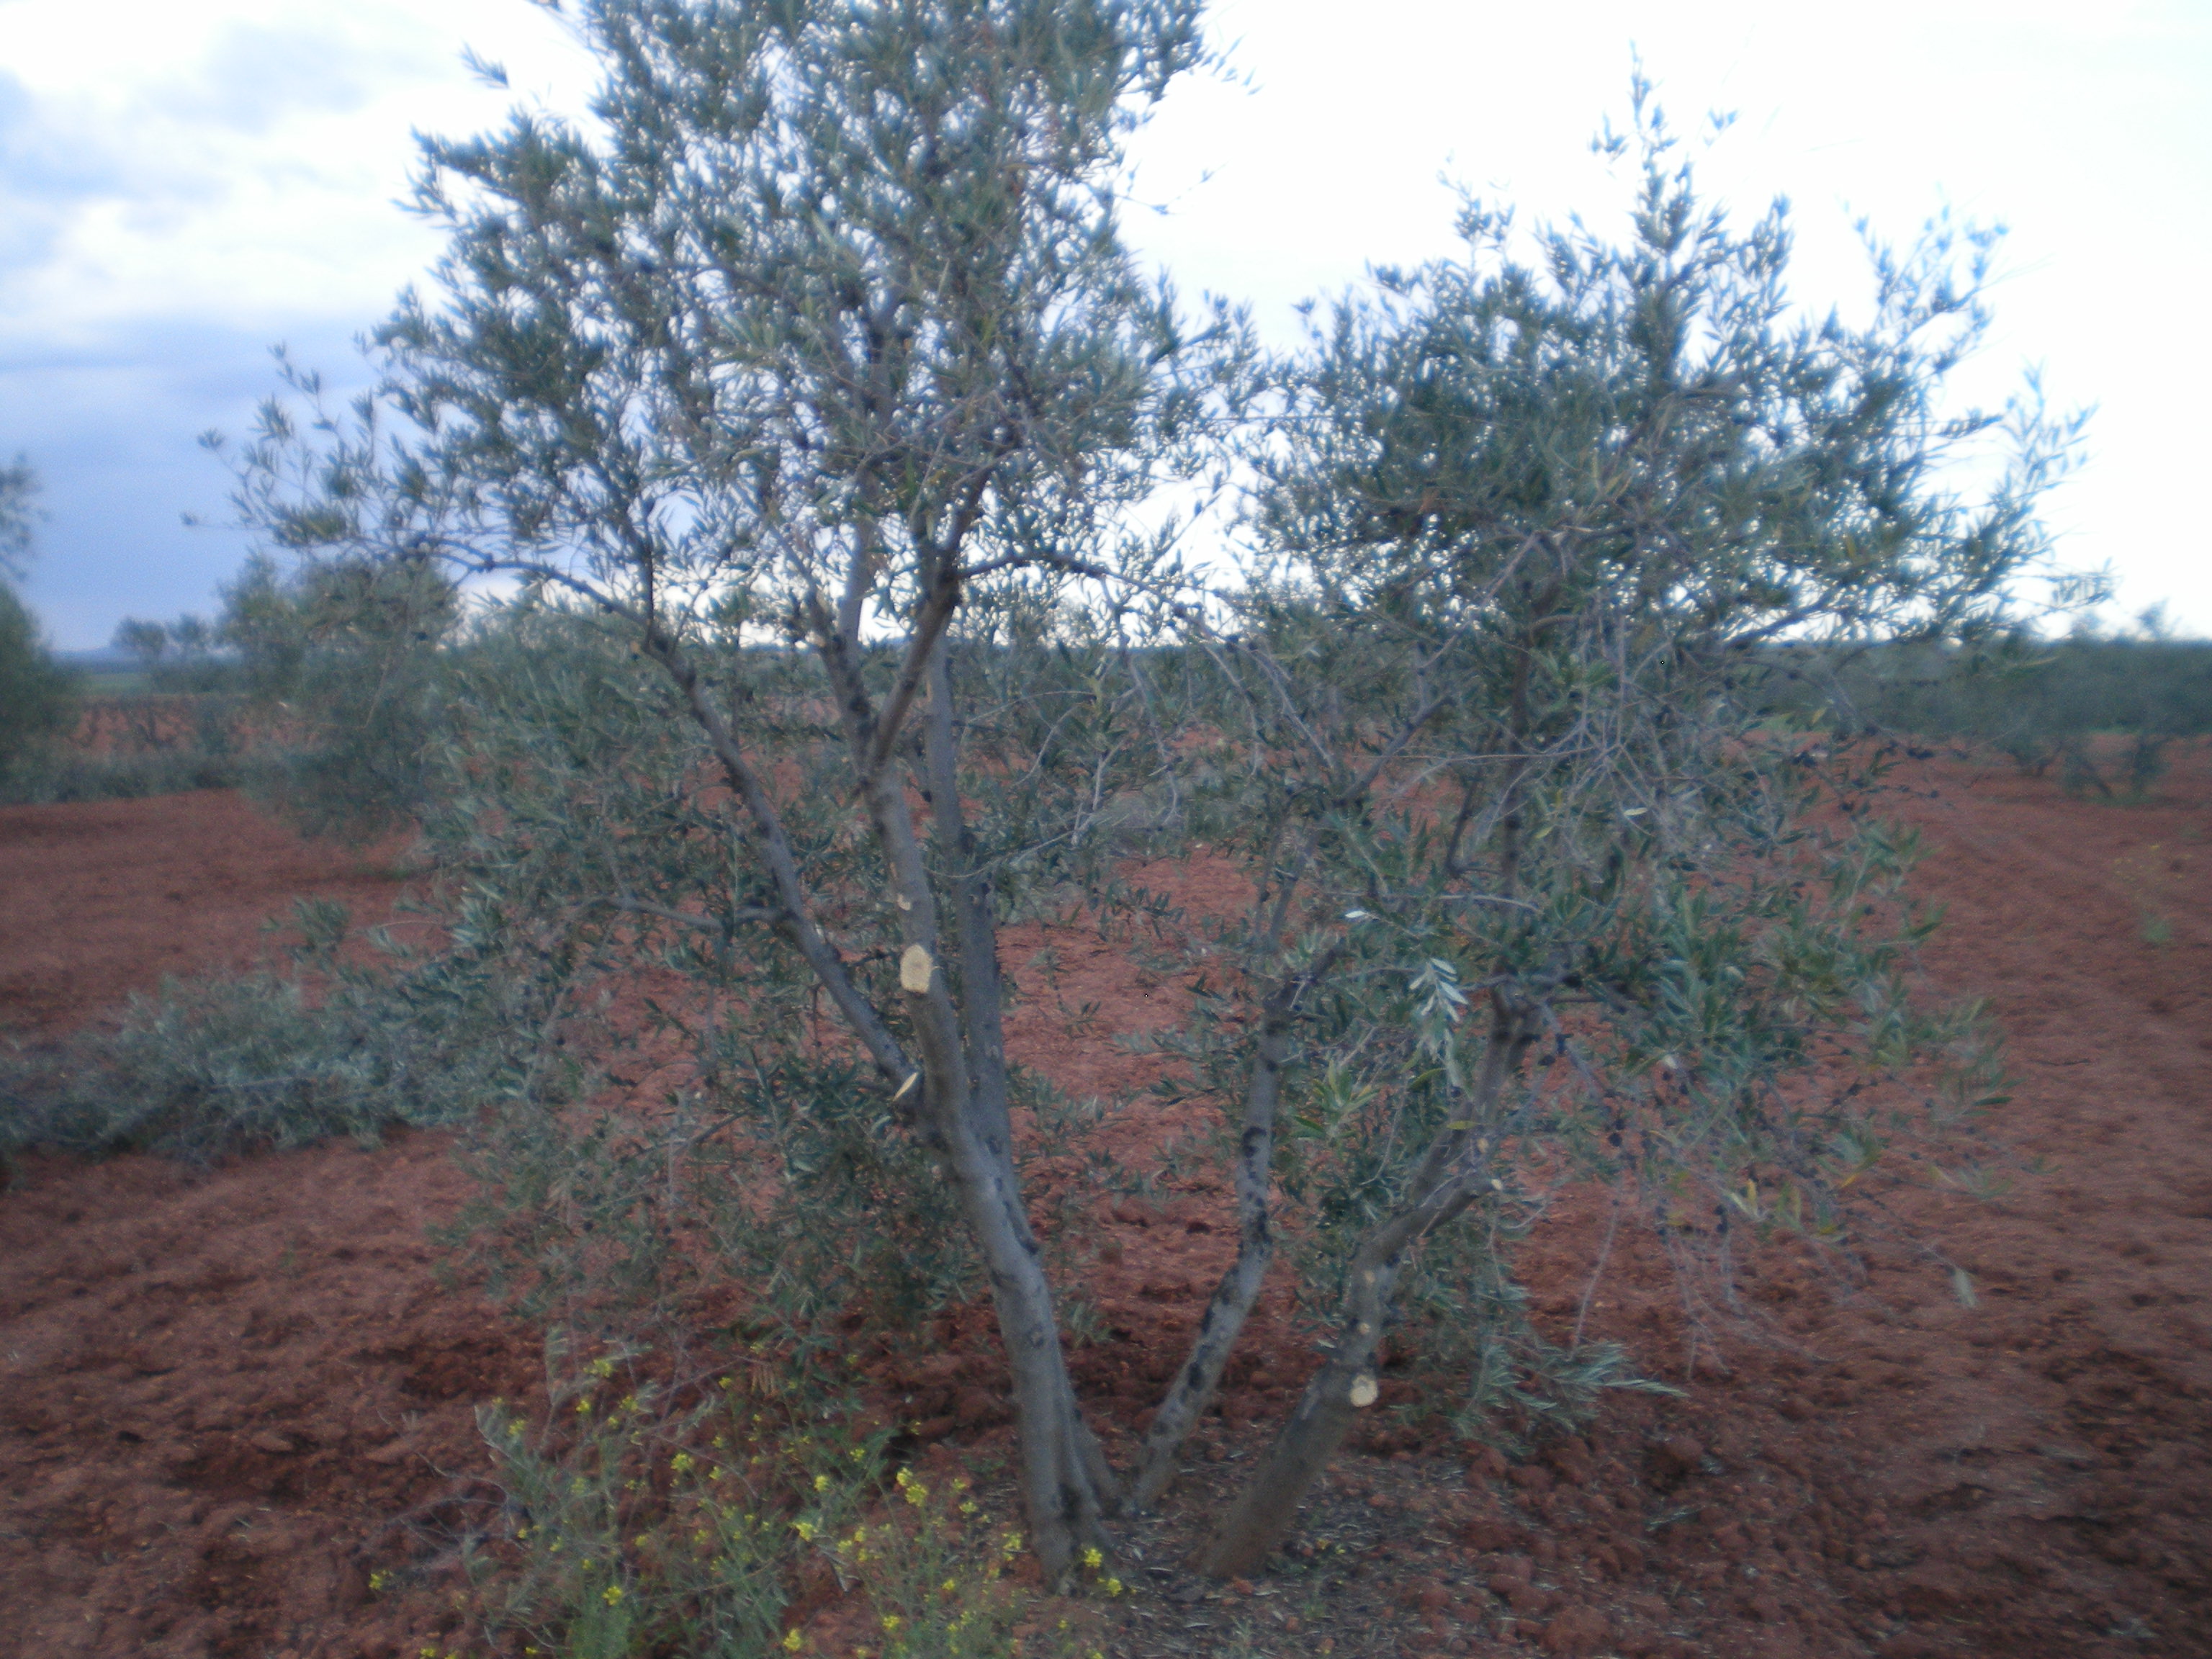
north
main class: Cropland
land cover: Olive groves
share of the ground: 10 - 25 %
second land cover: Other bare soil
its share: > 75 %
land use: Agriculture (excluding fallow land and kitchen gardens)
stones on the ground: < 10 %
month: April
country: ES
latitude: 38.6479
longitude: -3.3953
